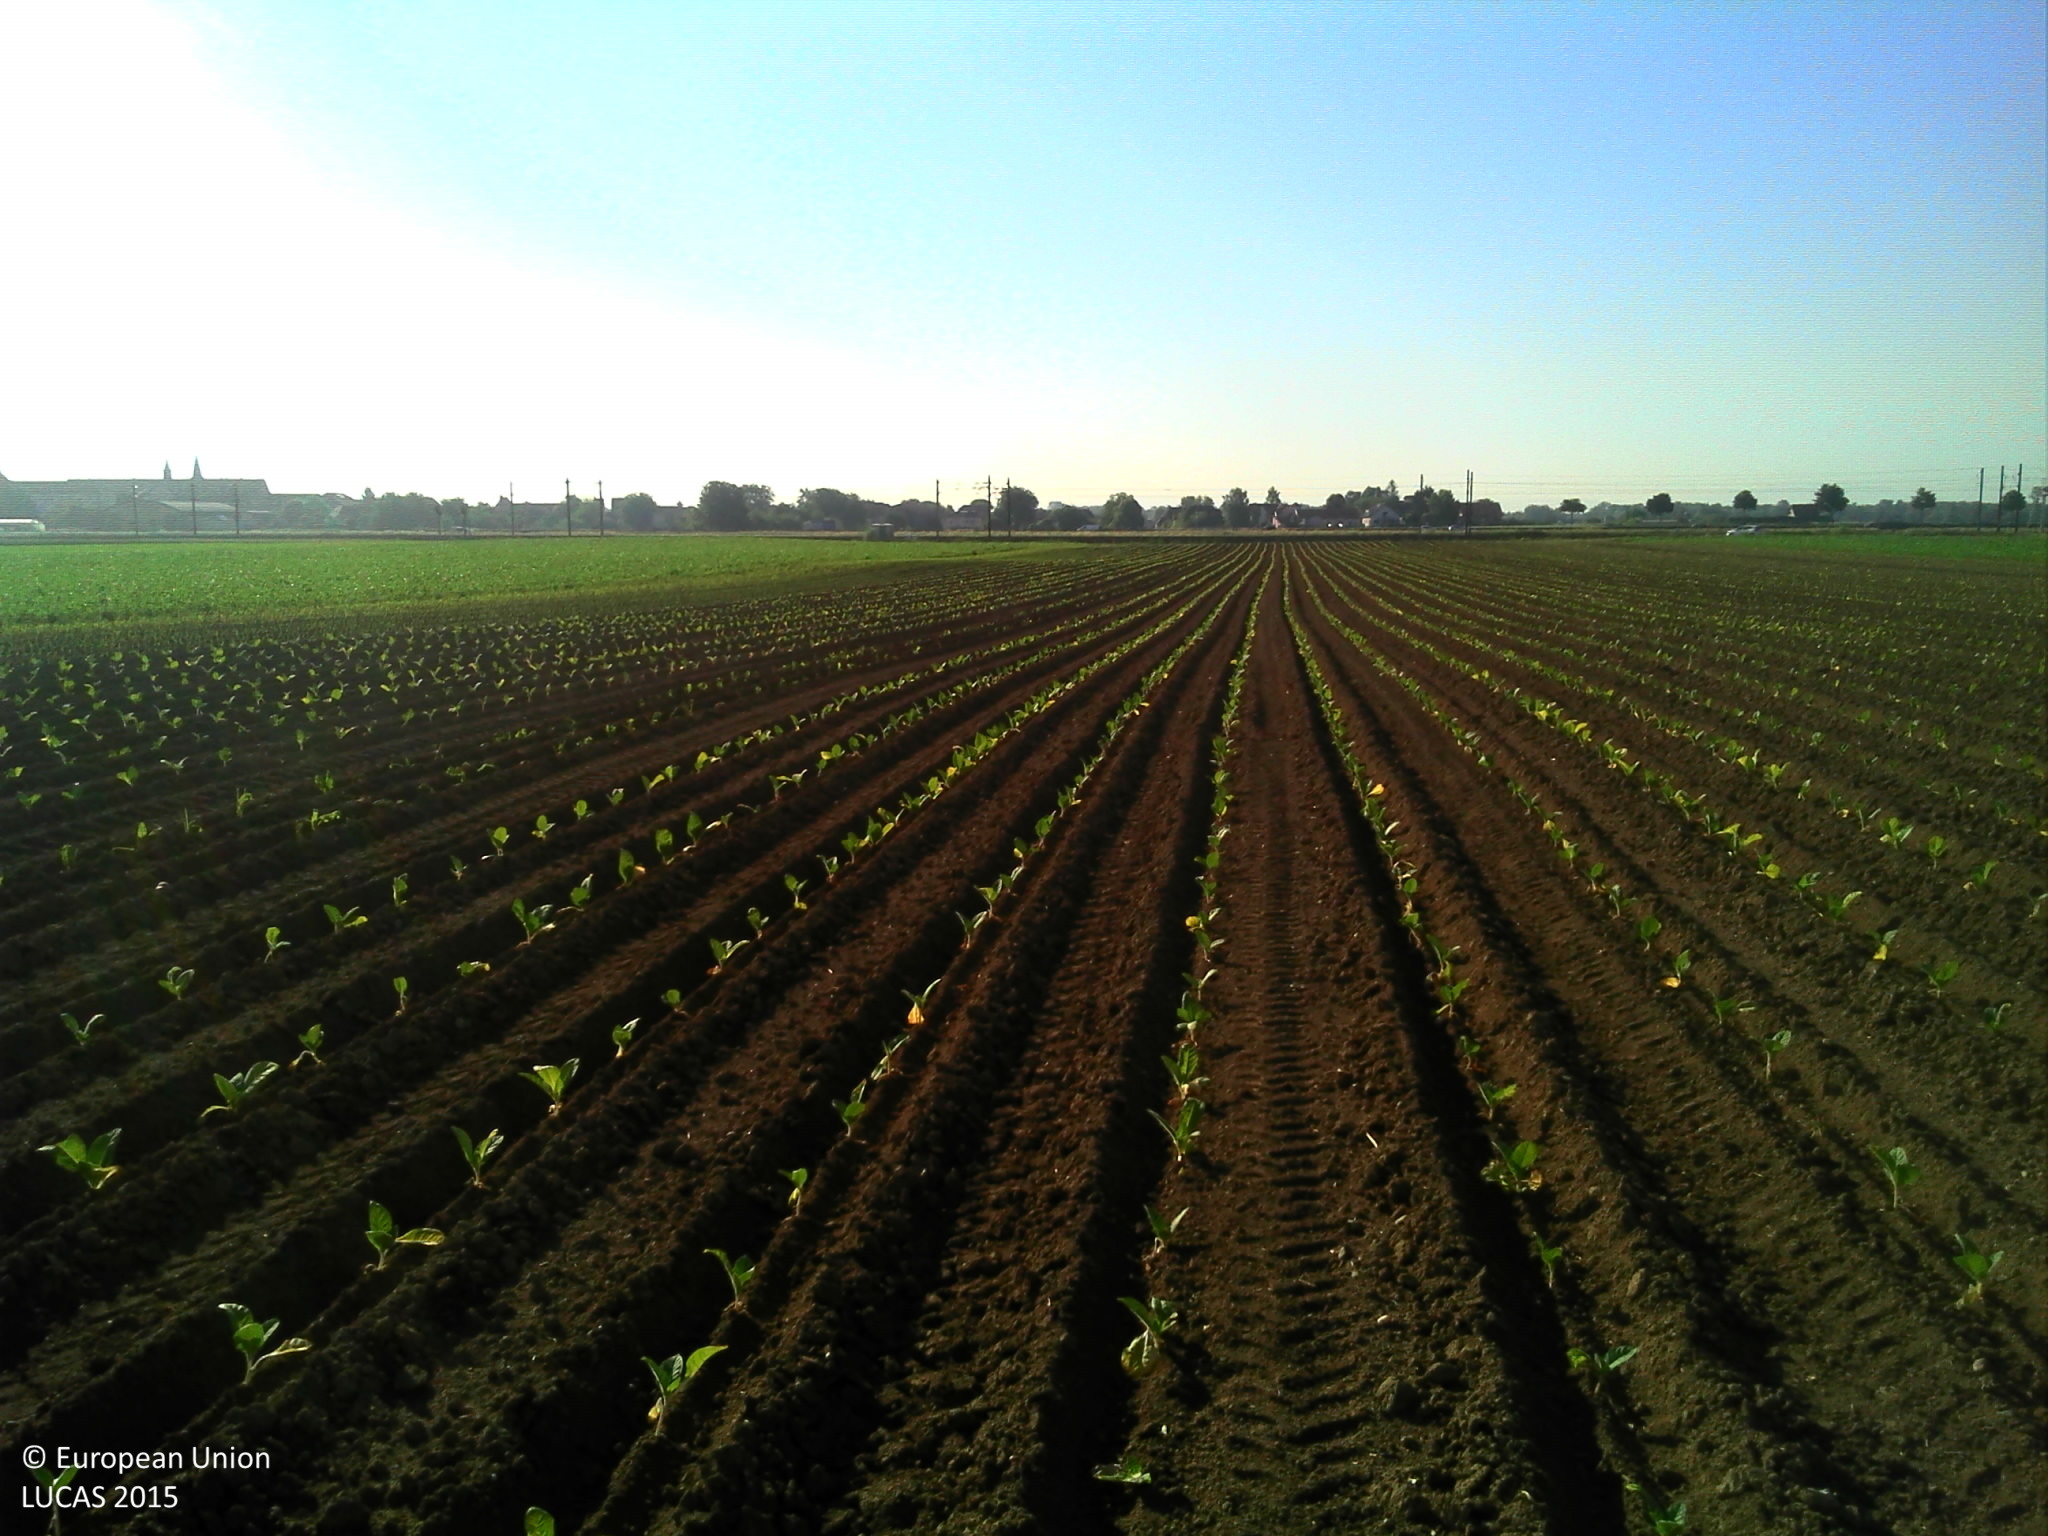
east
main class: Cropland
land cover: Tobacco
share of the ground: 10 - 25 %
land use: Agriculture (excluding fallow land and kitchen gardens)
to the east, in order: Tobacco; Maize; Common wheat
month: June
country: FR
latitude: 48.3957
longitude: 7.6104
